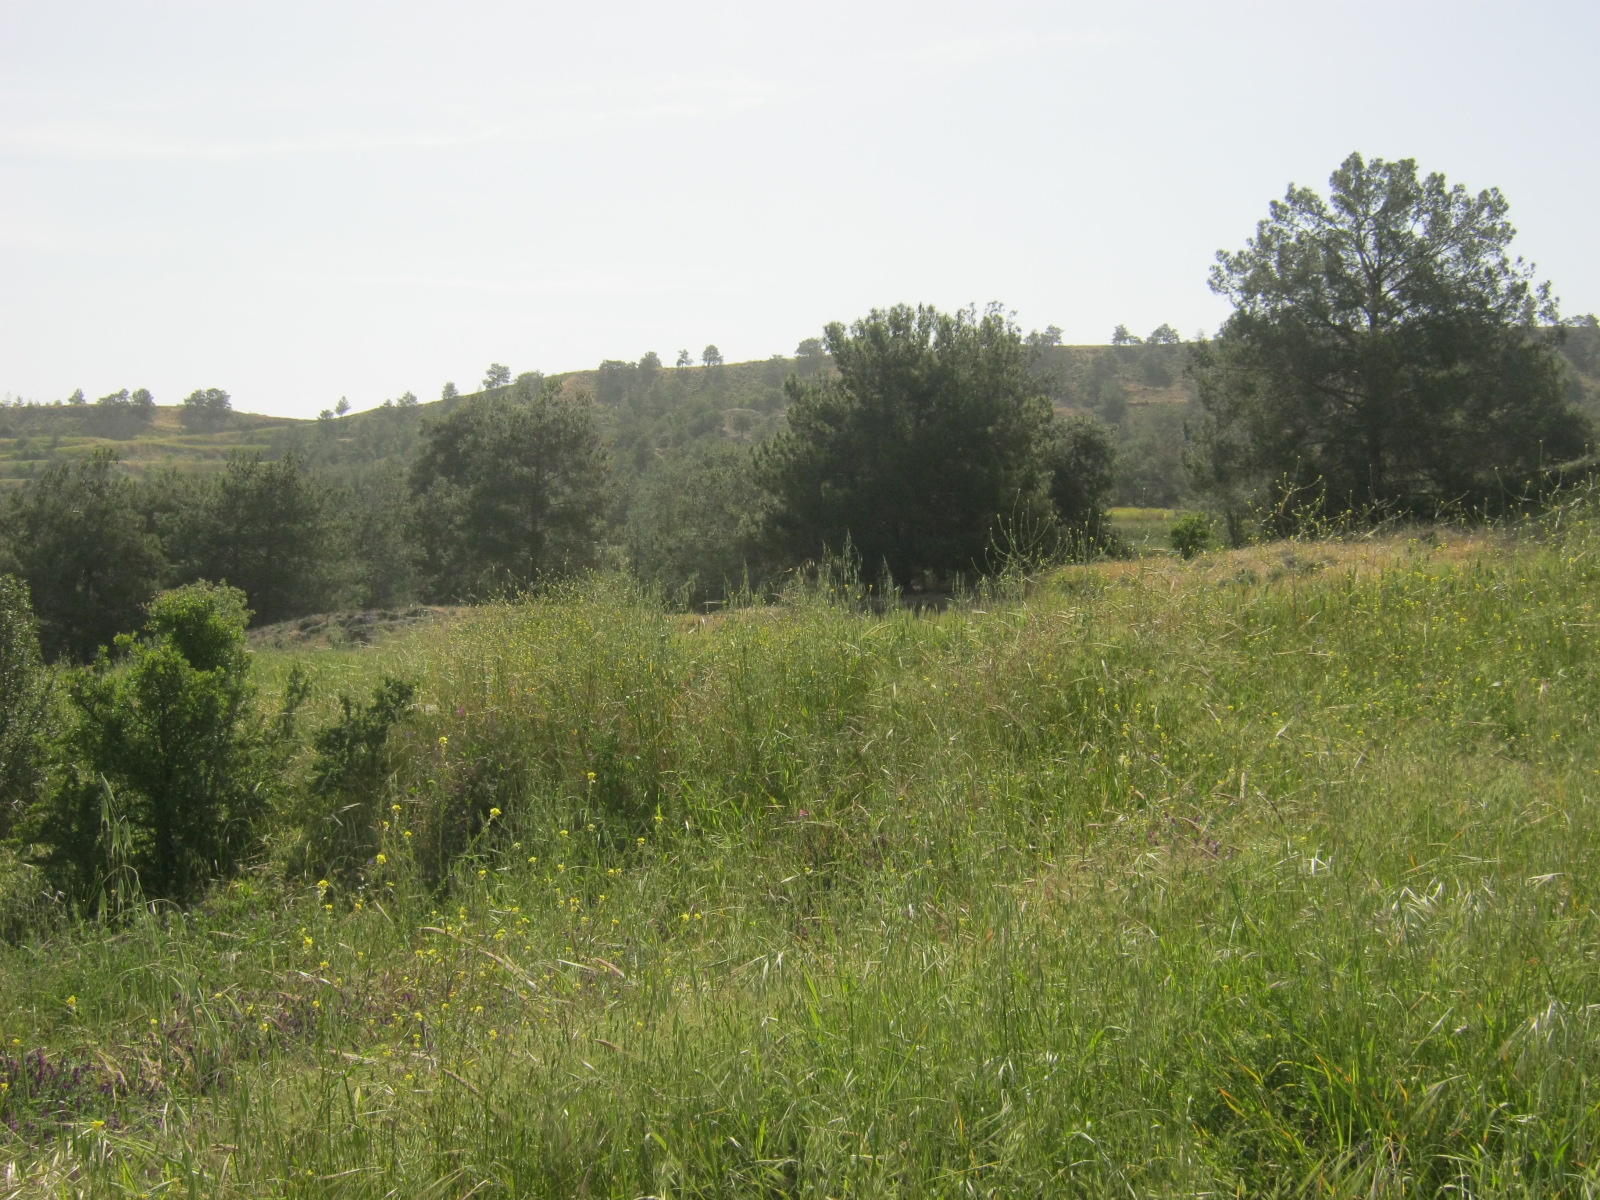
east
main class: Grassland
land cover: Grassland with sparse tree/shrub cover
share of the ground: > 75 %
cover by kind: herbaceous plants 95 %, broadleaved forest trees 5 %
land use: Semi-natural and natural areas not in use
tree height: > 5 m
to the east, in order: Grassland with sparse tree/shrub cover; Common wheat; Grassland without tree/shrub cover; Tracks; Grassland without tree/shrub cover; Pine dominated coniferous woodland; Tracks; Spontaneously vegetated surfaces; Pine dominated coniferous woodland; Paved roads, cycling and walking lanes; Pine dominated coniferous woodland; Grassland without tree/shrub cover; Tracks; Other bare soil; Artificial constructions in urban areas
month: April
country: CY
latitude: 35.0162
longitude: 33.2301
